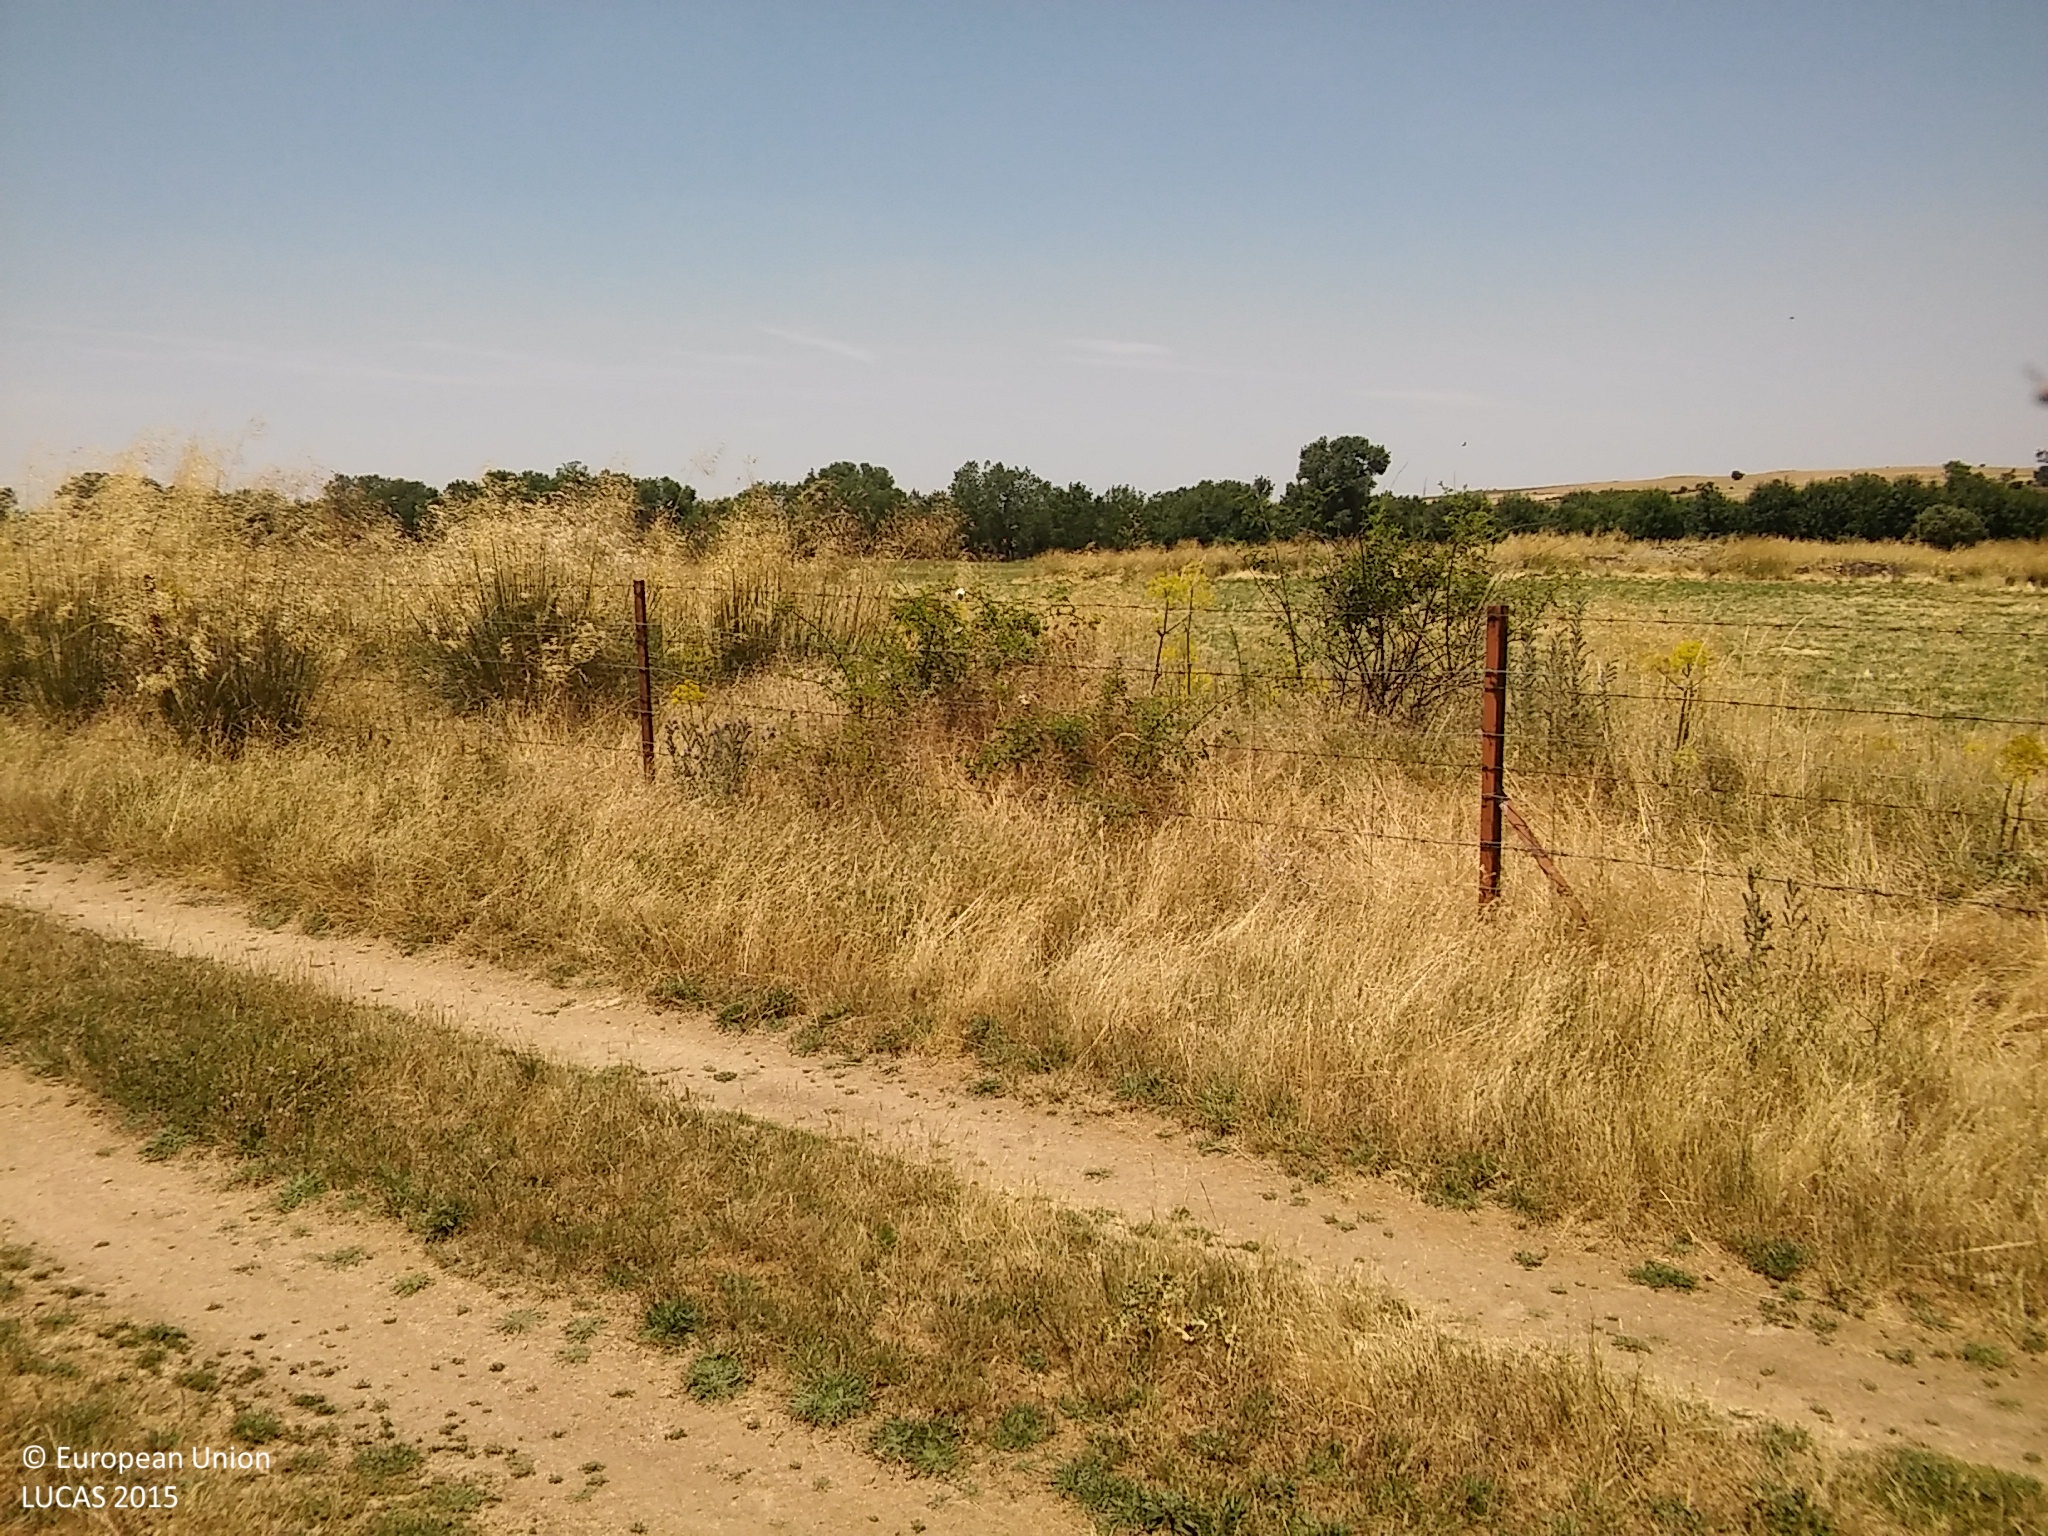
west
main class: Grassland
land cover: Grassland without tree/shrub cover
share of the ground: > 75 %
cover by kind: herbaceous plants 100 %
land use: Agriculture (excluding fallow land and kitchen gardens)
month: June
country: ES
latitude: 41.0806
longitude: -3.9401
